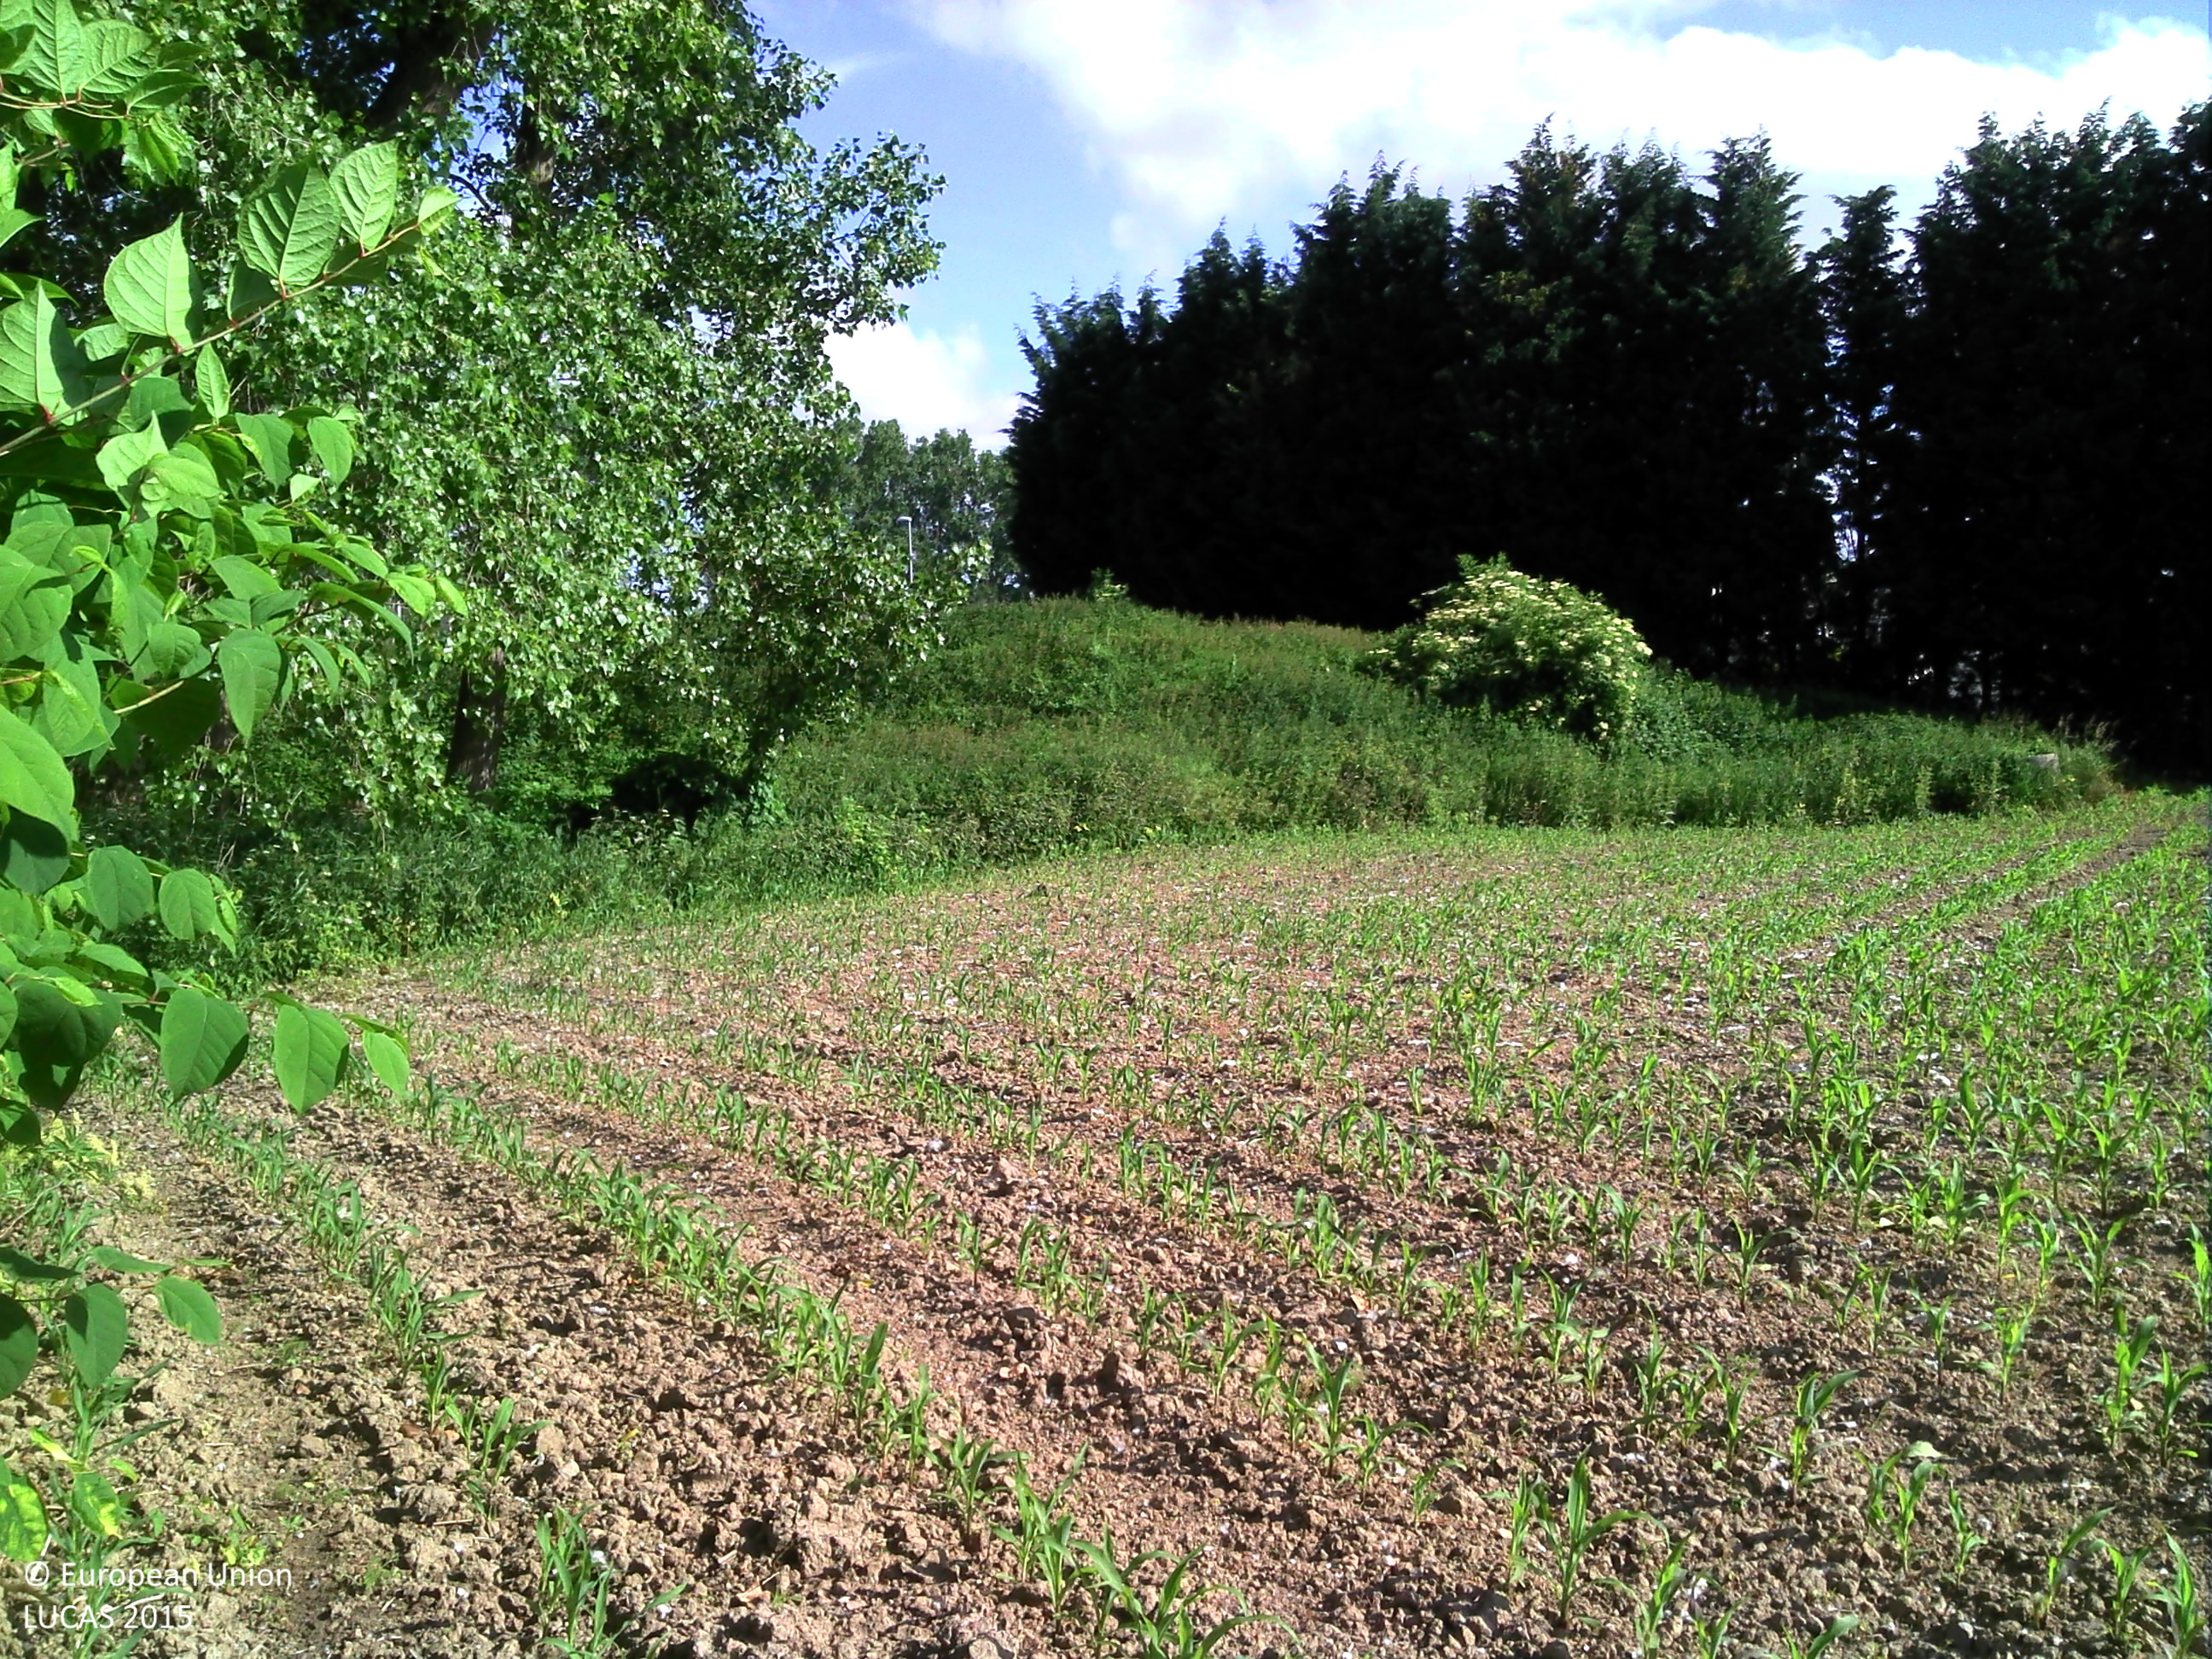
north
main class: Grassland
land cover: Spontaneously vegetated surfaces
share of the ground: > 75 %
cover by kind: herbaceous plants 100 %
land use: Semi-natural and natural areas not in use
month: June
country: BE
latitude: 51.0777
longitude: 5.7593
